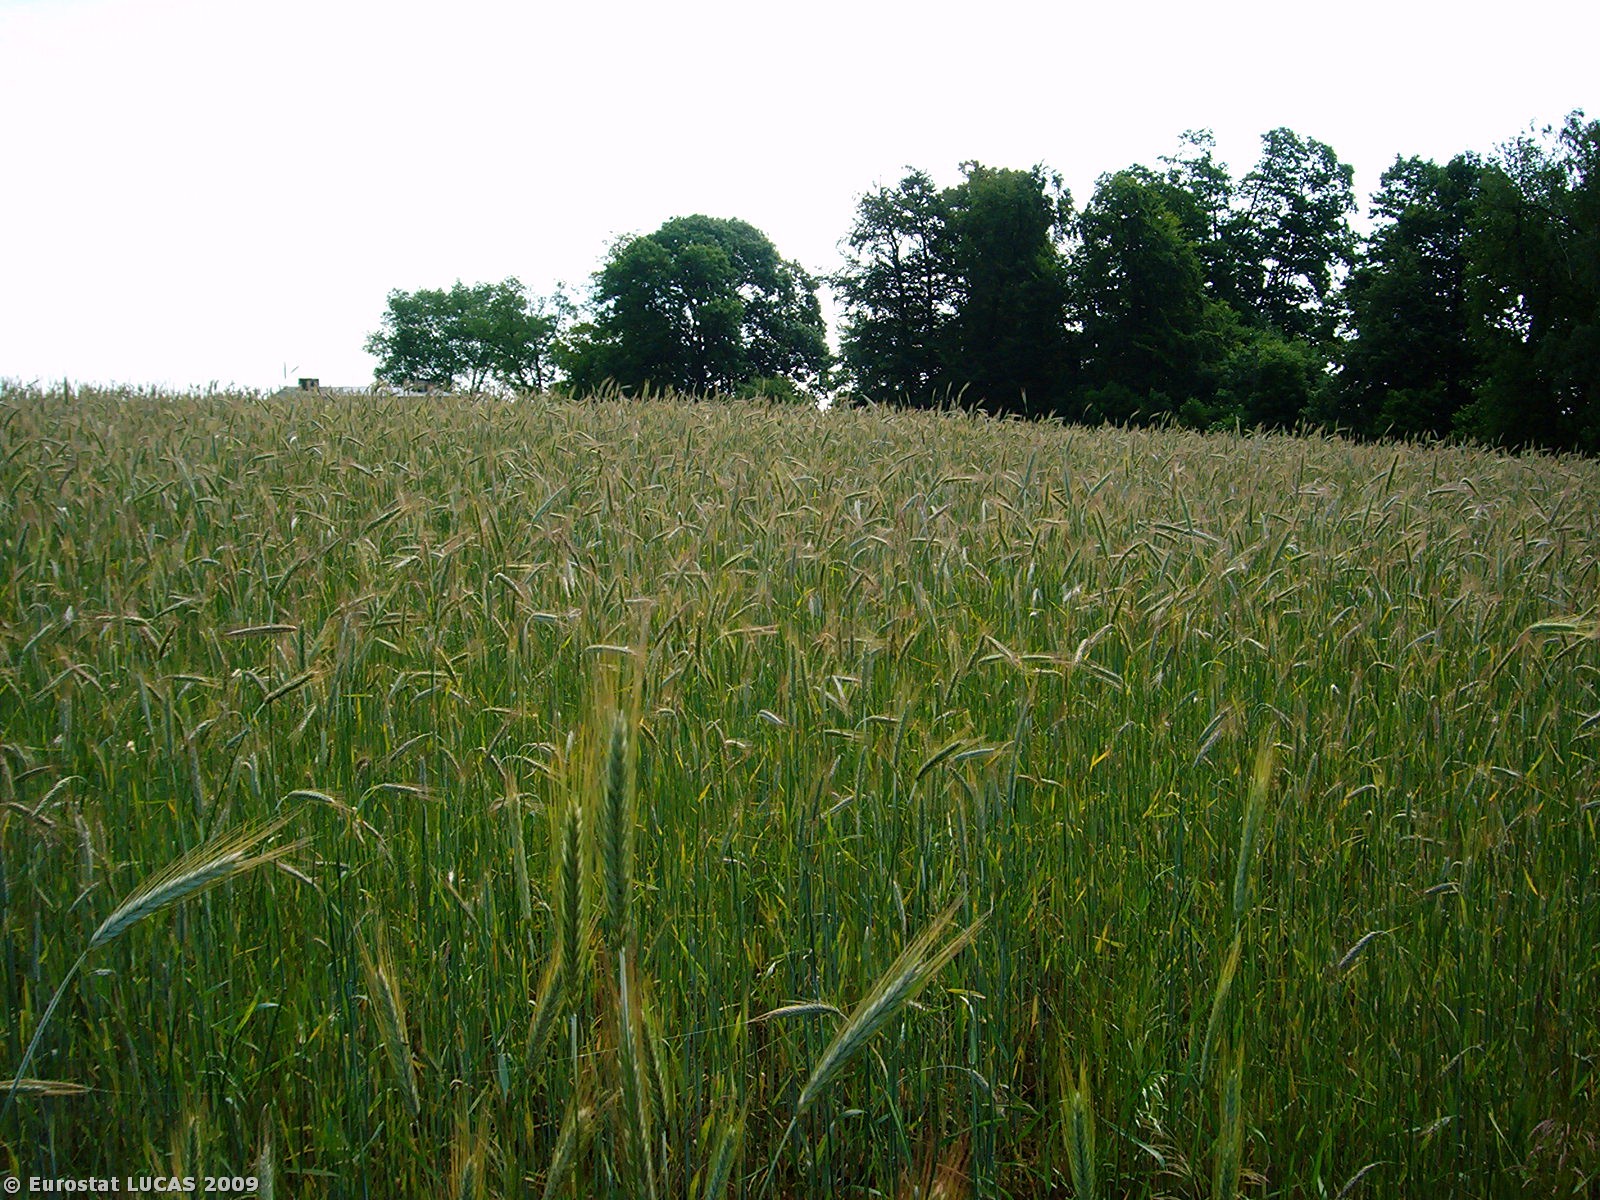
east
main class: Cropland
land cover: Triticale
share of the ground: > 75 %
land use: Agriculture (excluding fallow land and kitchen gardens)
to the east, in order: Triticale; Grass margins; Managed hedges; Artificial constructions in urban areas; Paved roads, cycling and walking lanes
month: June
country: PL
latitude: 53.6721
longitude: 15.5282
